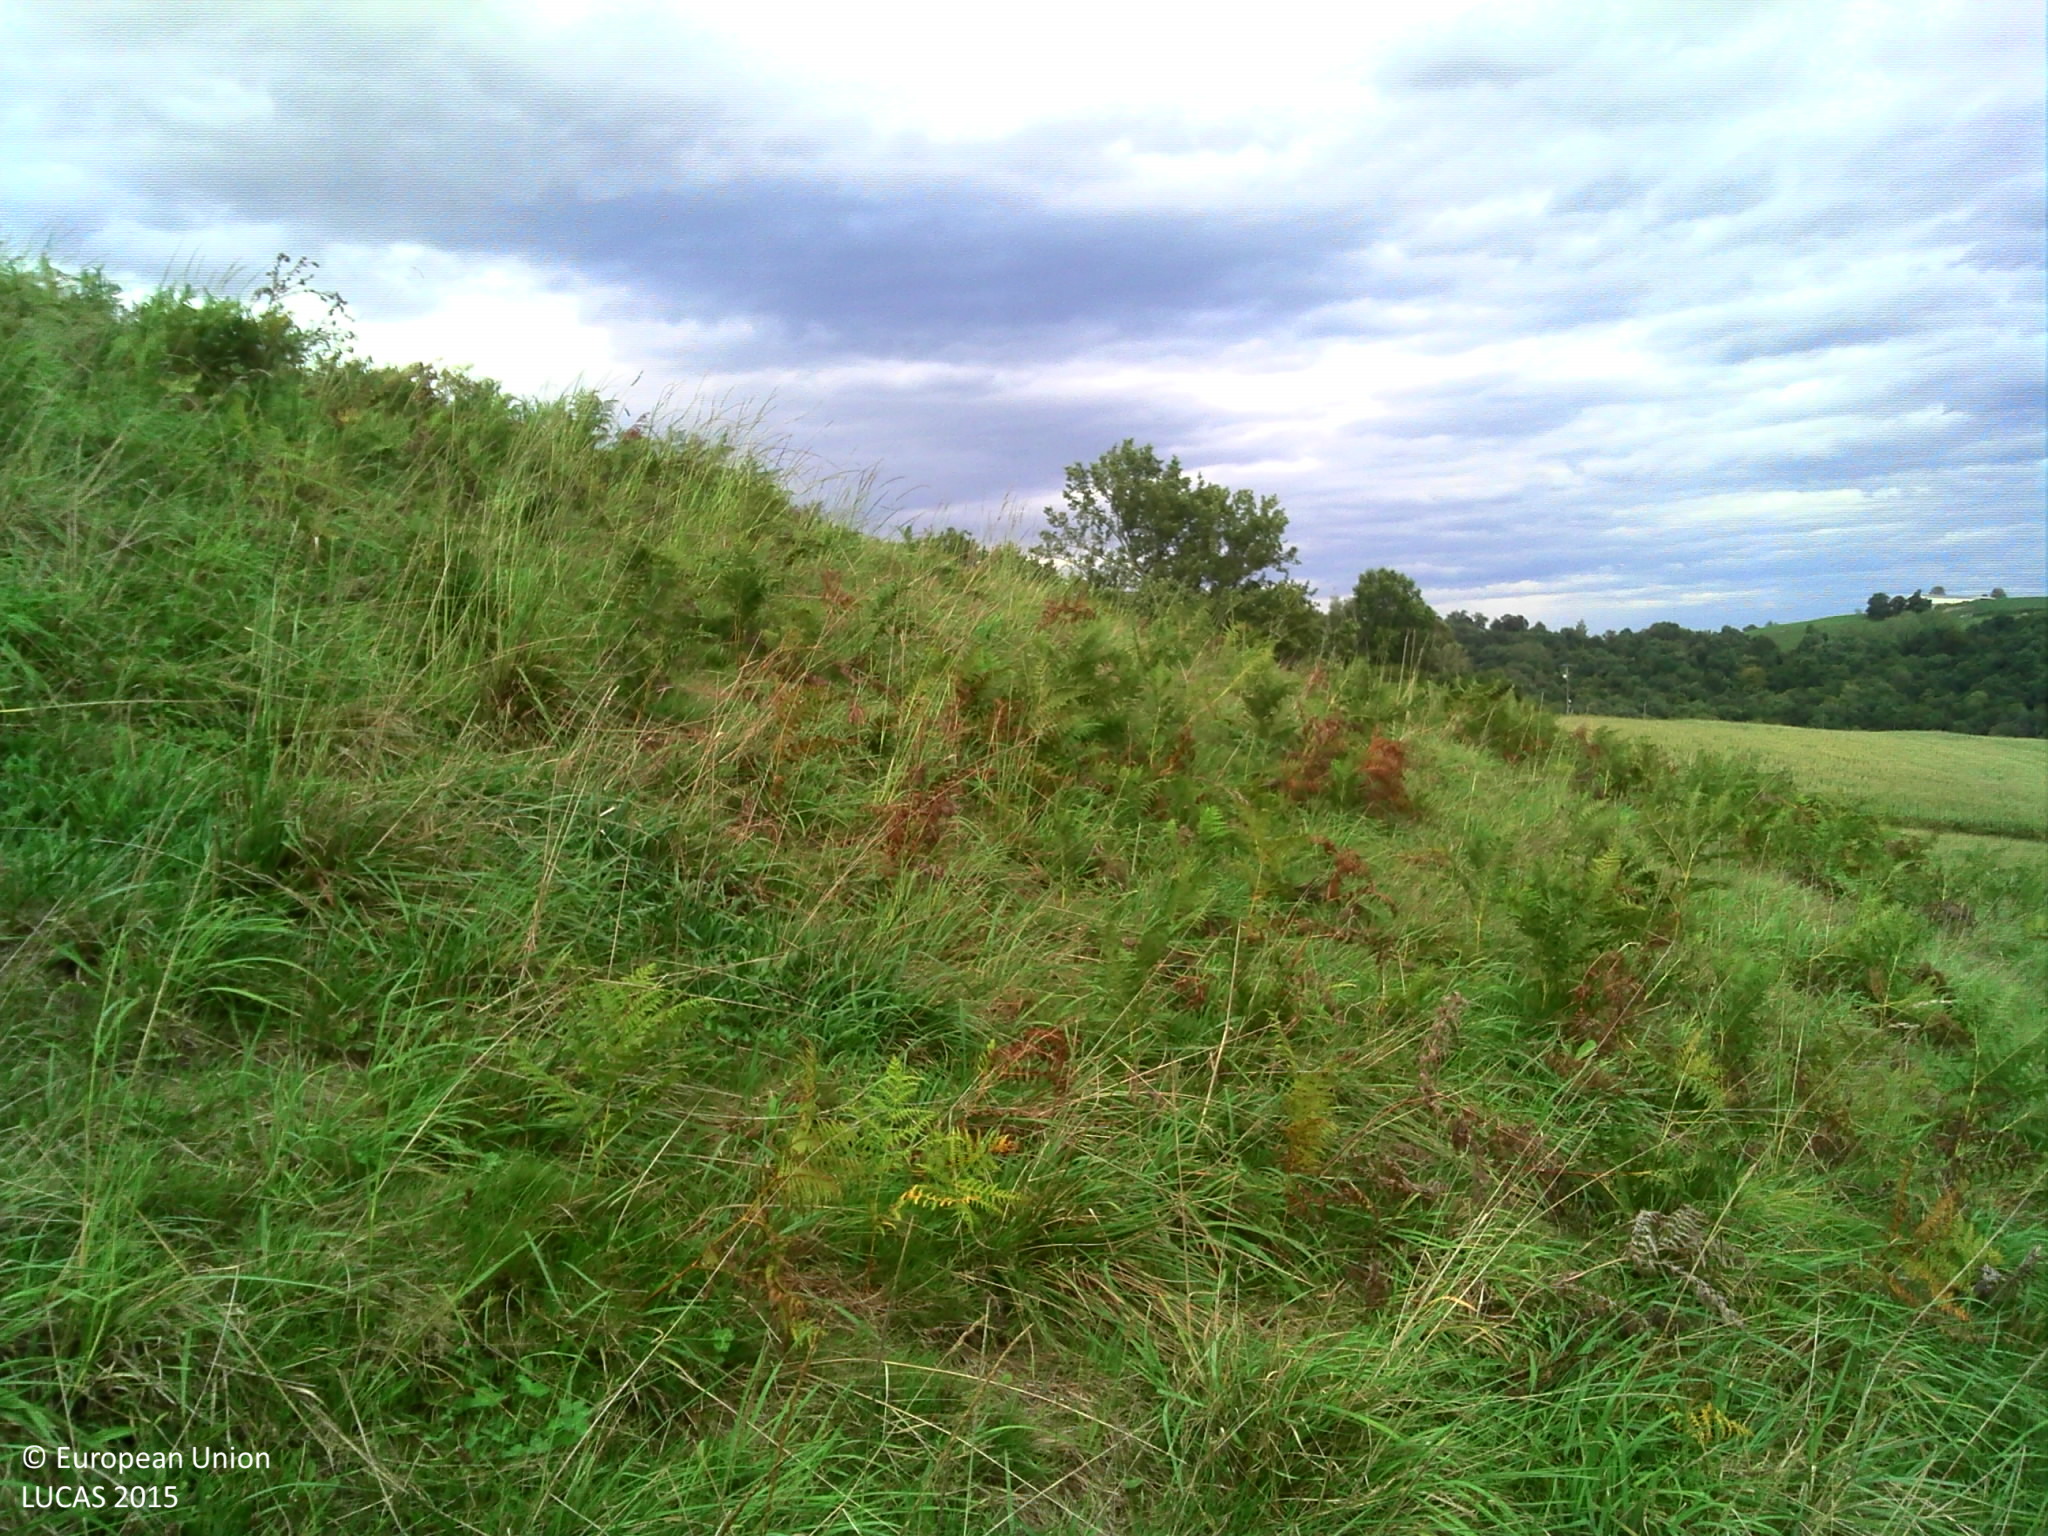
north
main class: Grassland
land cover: Grassland without tree/shrub cover
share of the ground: > 75 %
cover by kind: herbaceous plants 95 %, shrubs 5 %
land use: Agriculture (excluding fallow land and kitchen gardens)
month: September
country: FR
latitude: 43.3942
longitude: -0.7142
